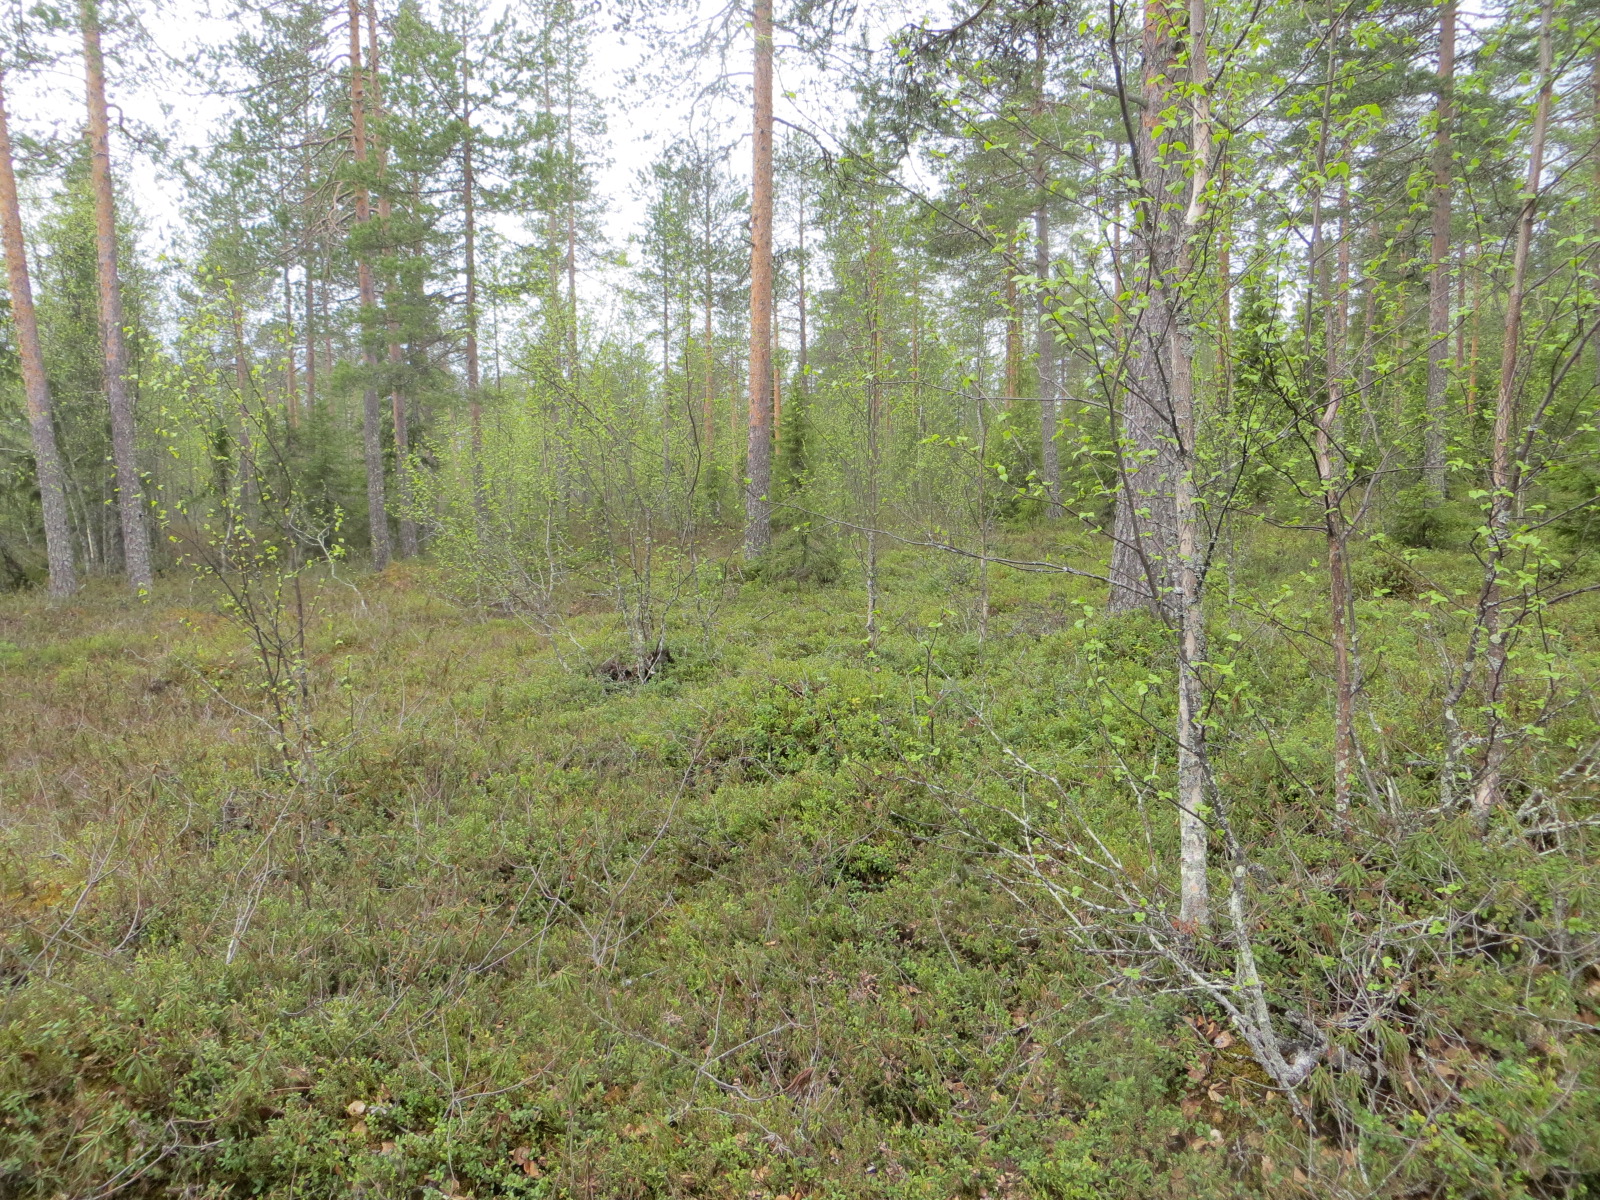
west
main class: Woodland
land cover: Pine dominated mixed woodland
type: boreal forest
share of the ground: 50 - 75 %
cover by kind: coniferous forest trees 35 %, broadleaved forest trees 35 %, shrubs 25 %, lichens and mosses 5 %
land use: Forestry
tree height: > 5 m
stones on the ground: < 10 %
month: June
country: FI
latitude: 66.5447
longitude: 25.8075
